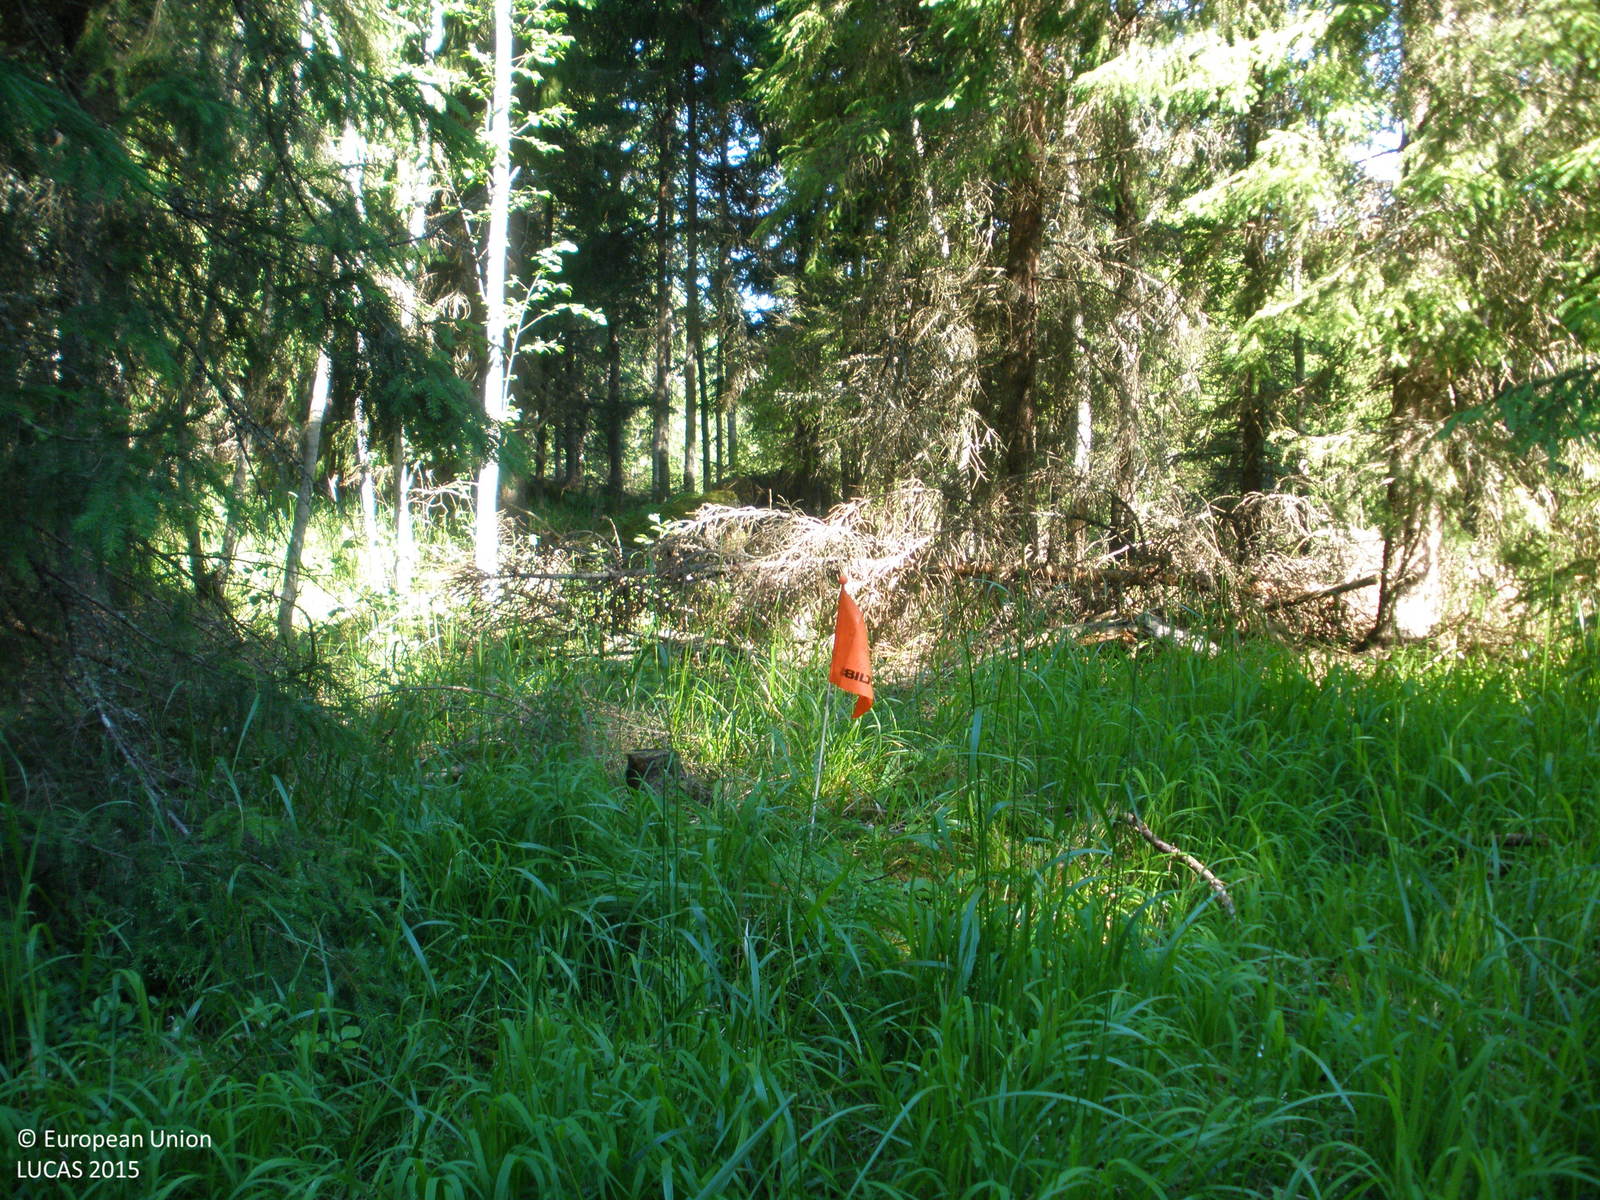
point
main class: Woodland
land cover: Spruce dominated mixed woodland
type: boreal forest
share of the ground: > 75 %
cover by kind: coniferous forest trees 60 %, broadleaved forest trees 25 %, herbaceous plants 15 %
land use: Forestry
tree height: > 5 m
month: July
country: FI
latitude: 61.1949
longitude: 23.6852
